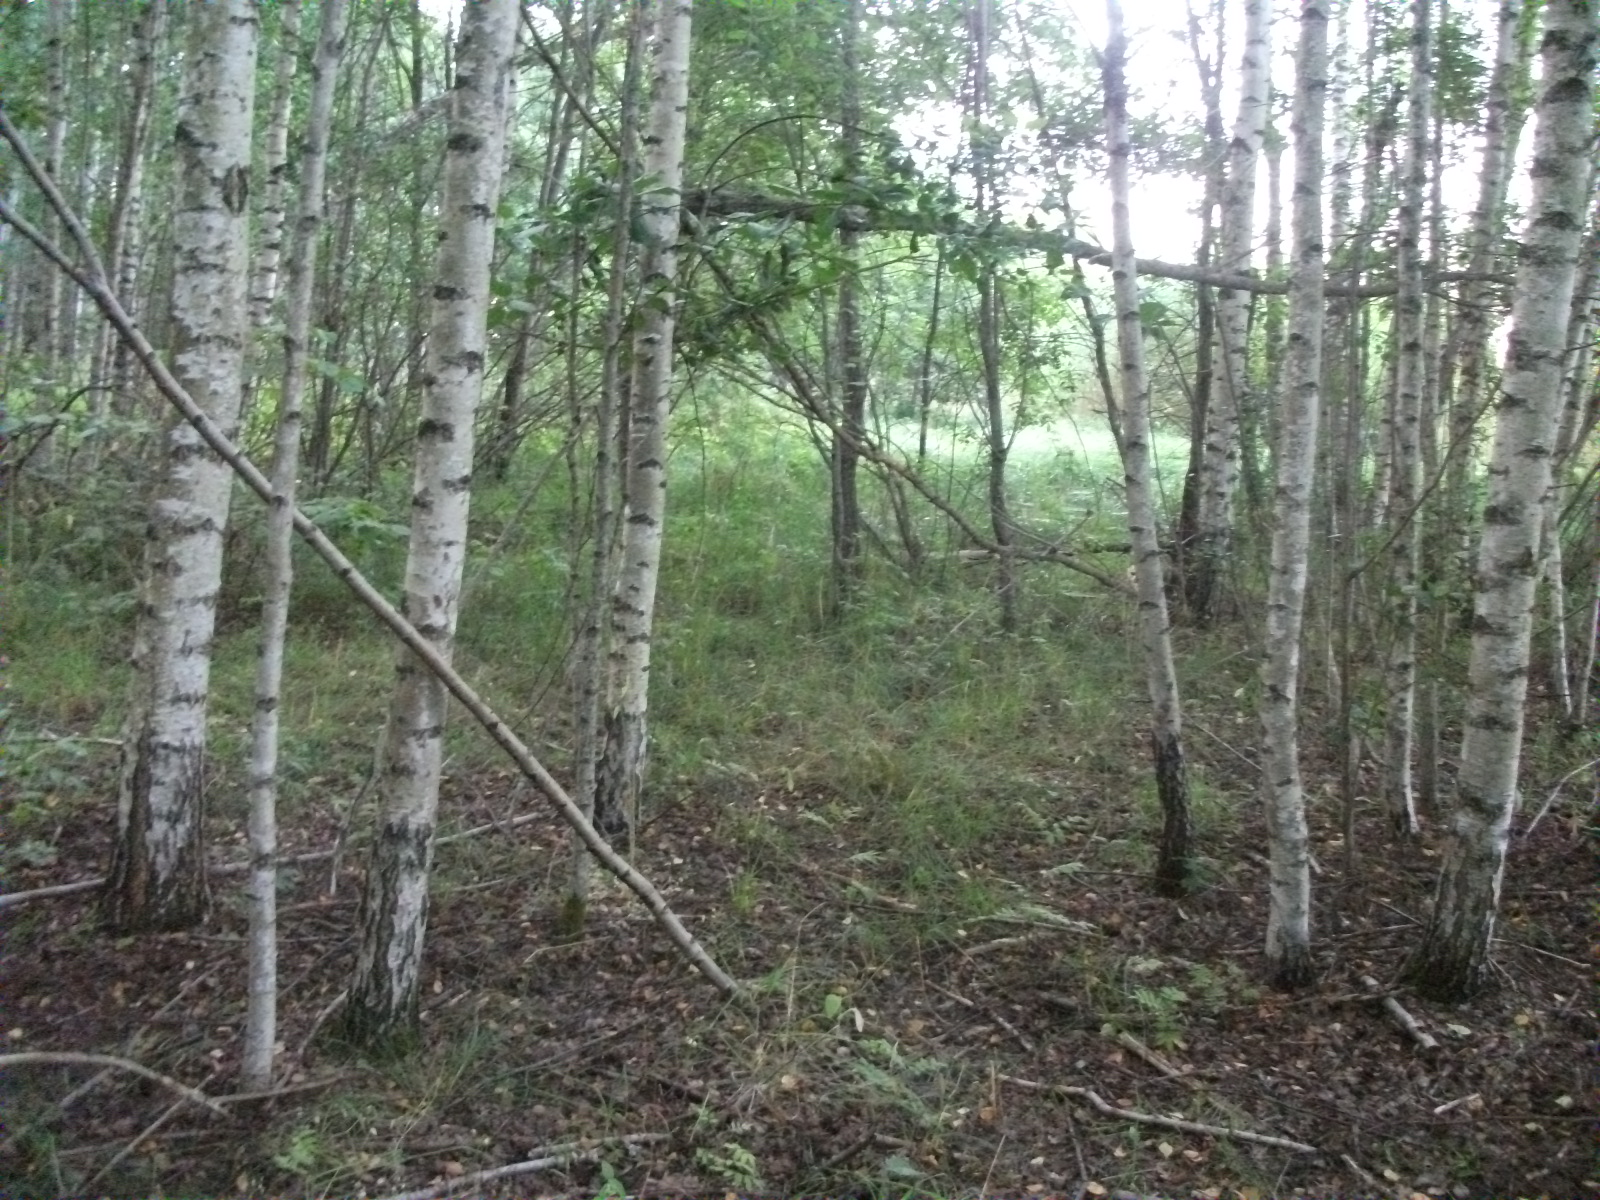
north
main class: Woodland
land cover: Broadleaved woodland
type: non-riverine alder, birch or aspen forest
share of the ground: > 75 %
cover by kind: broadleaved forest trees 80 %, unconsolidated bare surface 10 %, herbaceous plants 5 %
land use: Forestry
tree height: > 5 m
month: August
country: LV
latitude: 56.7662
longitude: 26.4901
